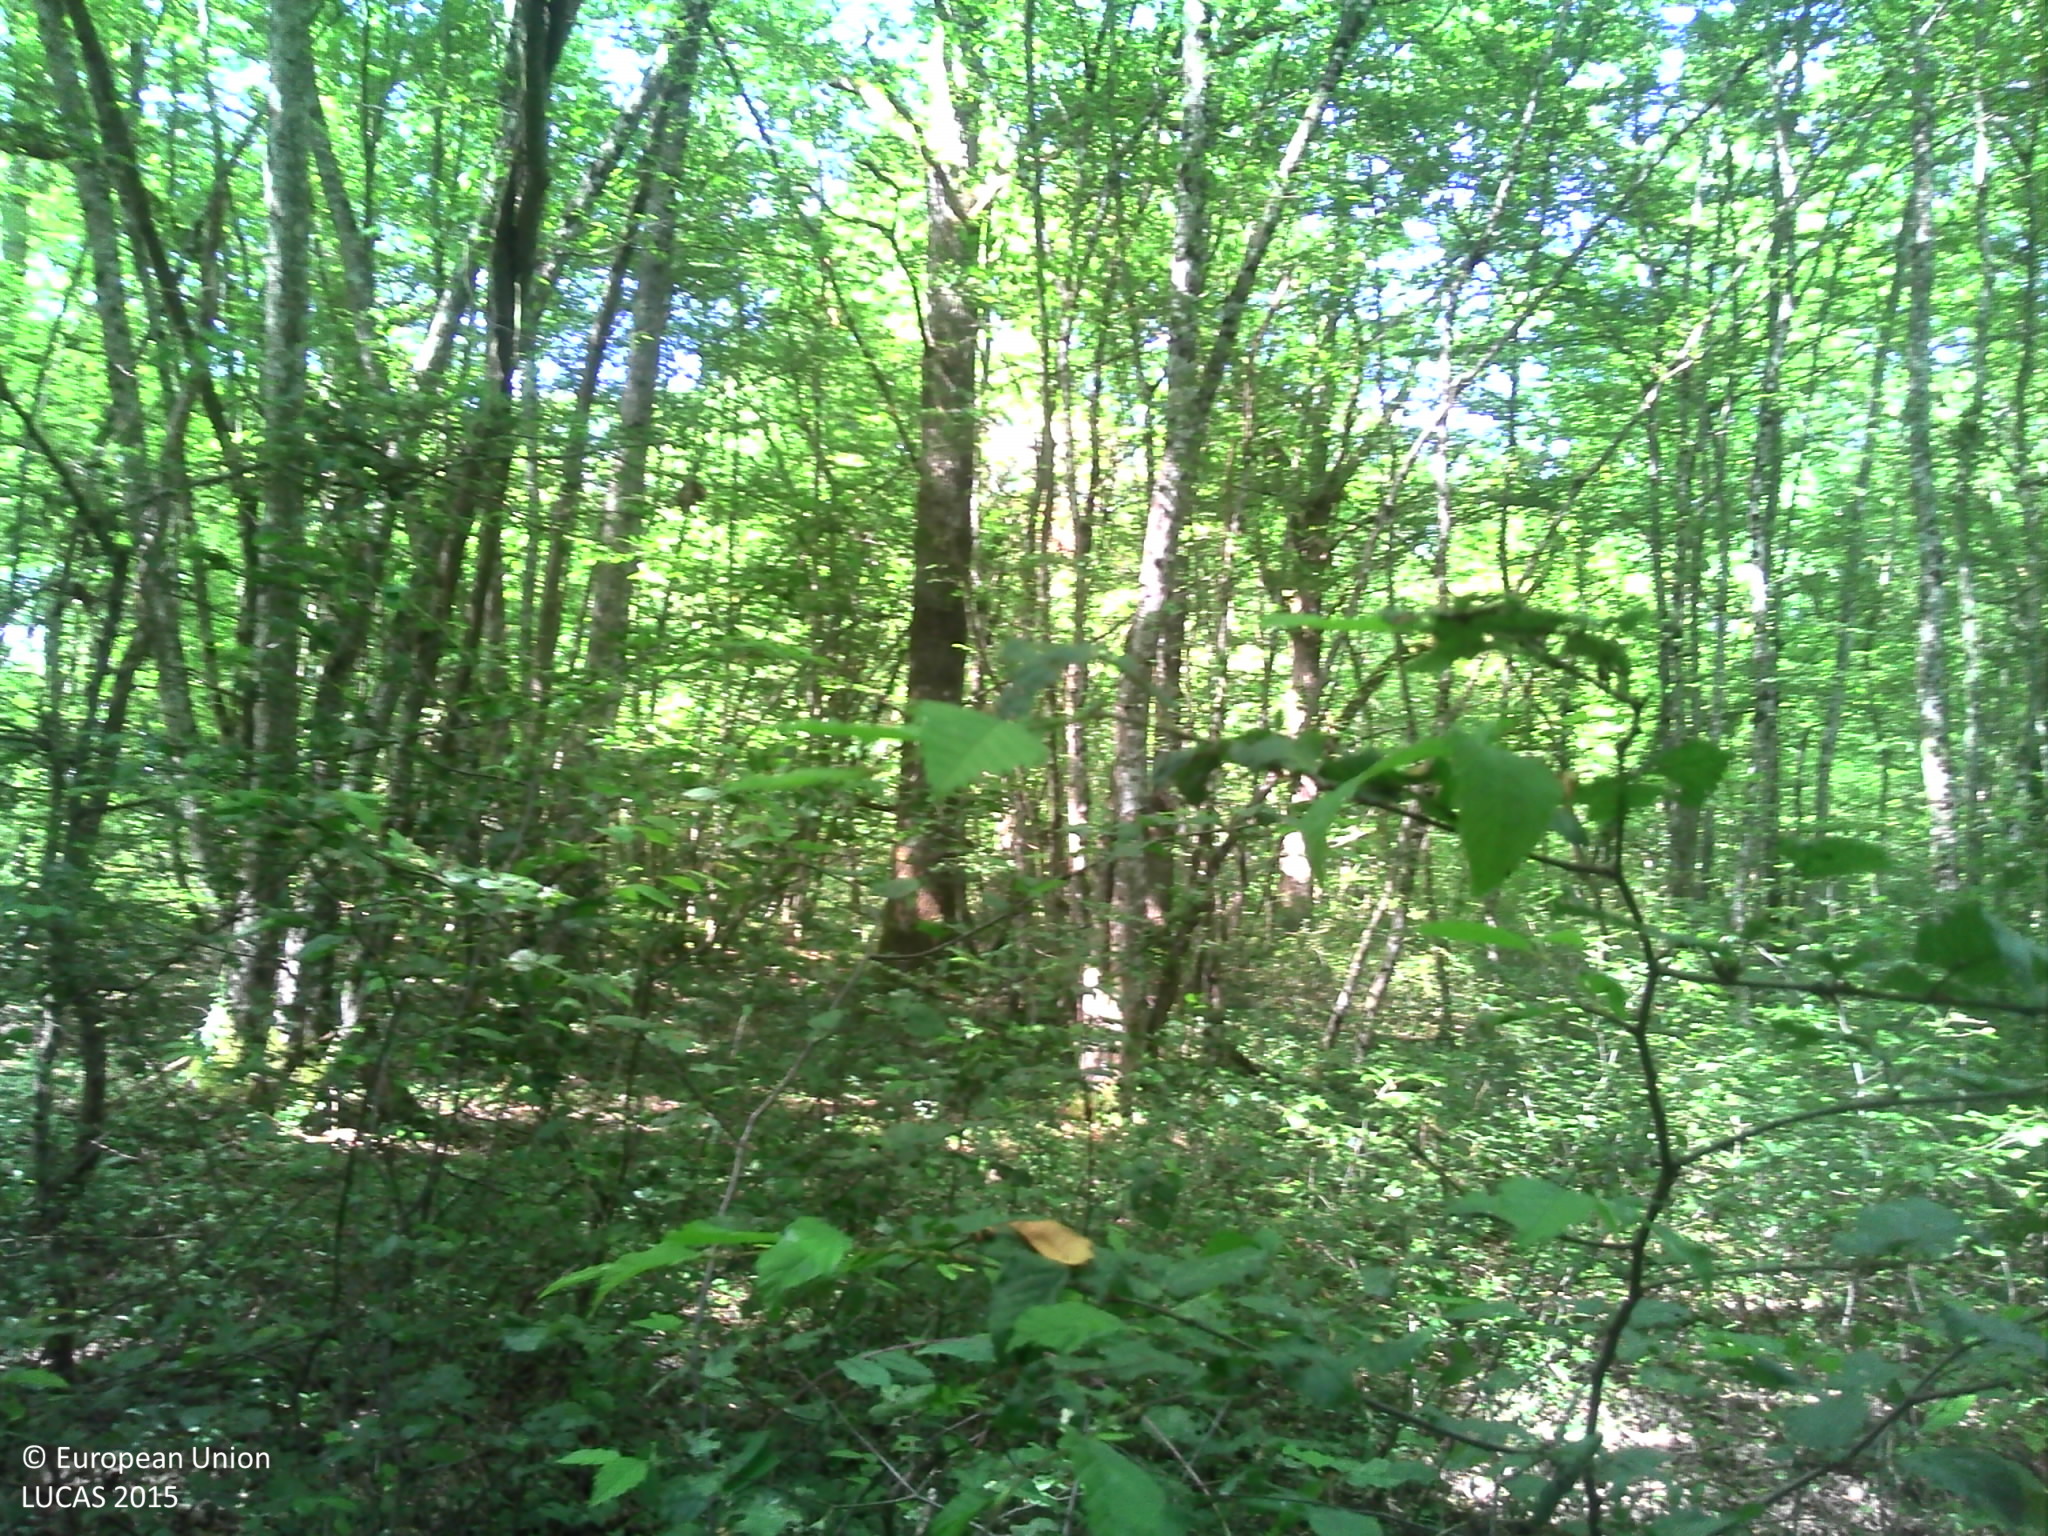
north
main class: Woodland
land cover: Broadleaved woodland
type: mesophytic deciduous forest
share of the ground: > 75 %
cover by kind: broadleaved forest trees 95 %, herbaceous plants 5 %
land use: Forestry
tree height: > 5 m
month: June
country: FR
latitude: 47.7516
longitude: 2.5082
